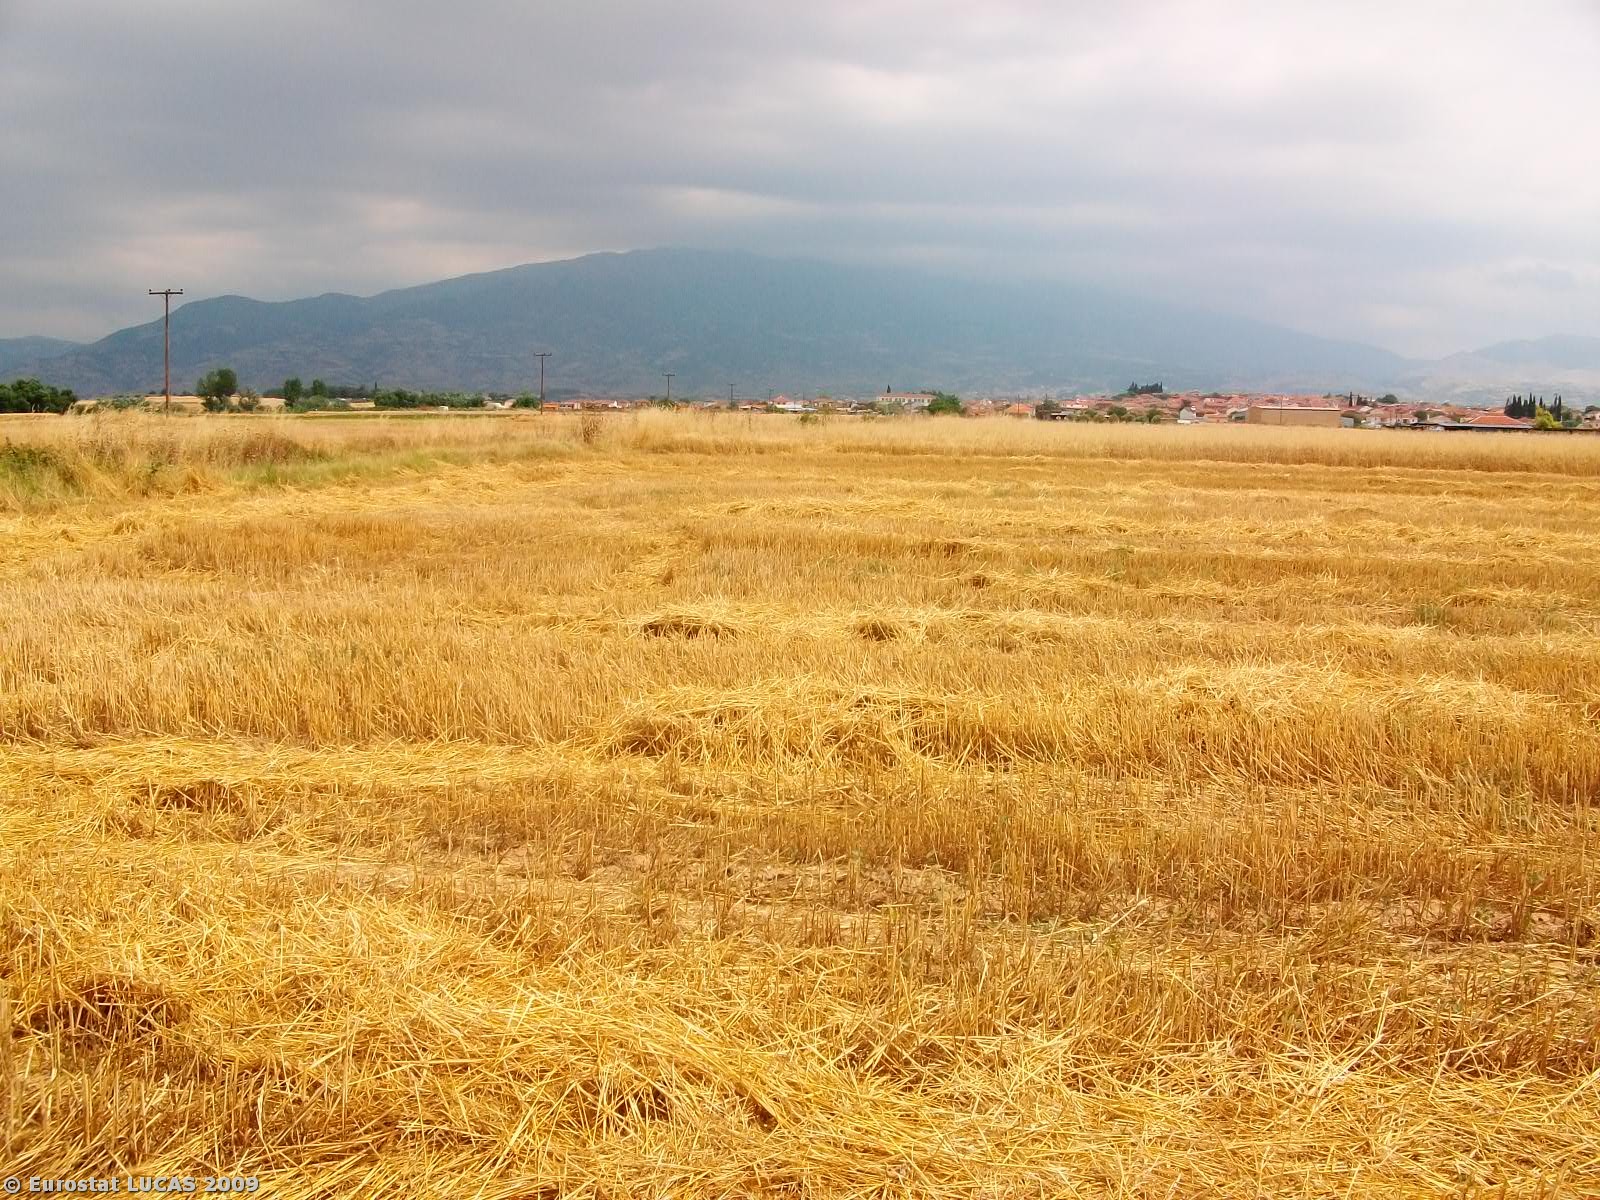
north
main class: Cropland
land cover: Durum wheat
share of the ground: > 75 %
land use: Agriculture (excluding fallow land and kitchen gardens)
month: June
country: GR
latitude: 41.0490
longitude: 23.6433
